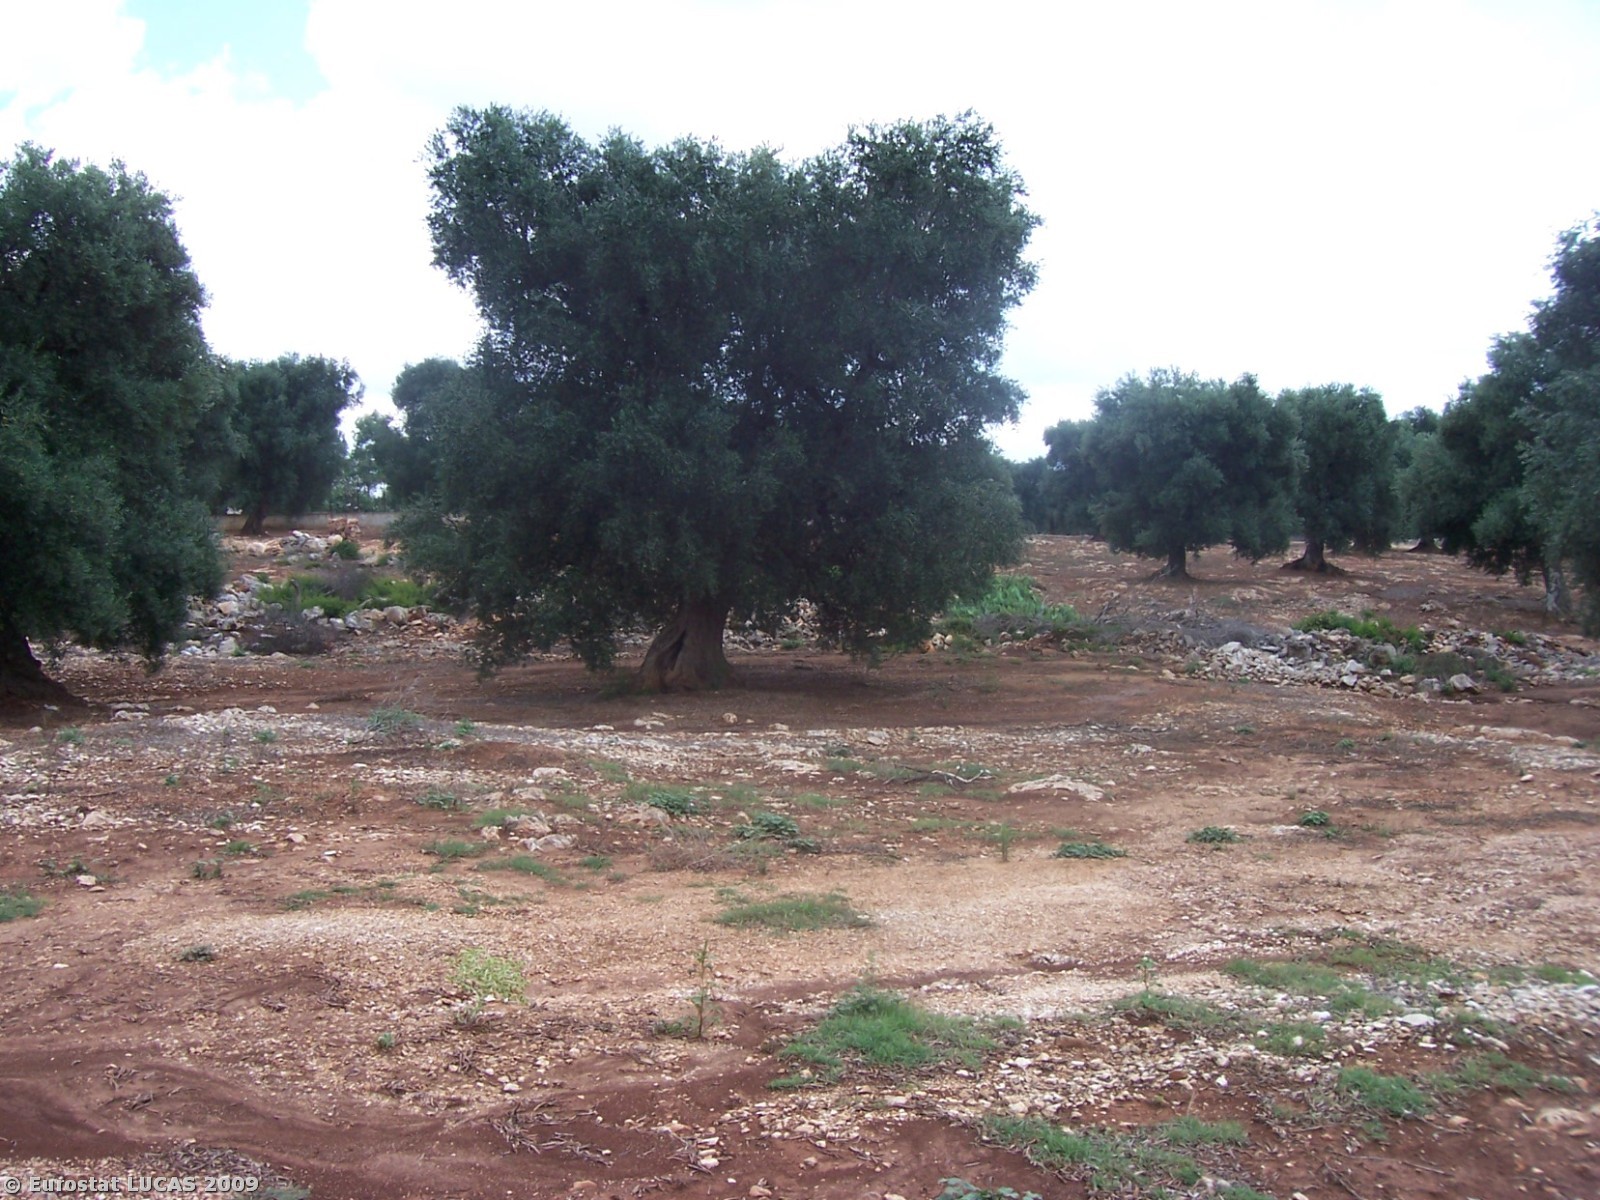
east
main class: Cropland
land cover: Olive groves
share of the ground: 50 - 75 %
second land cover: Bare land
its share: > 75 %
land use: Agriculture (excluding fallow land and kitchen gardens)
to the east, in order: Olive groves; Bare land; Tracks; Olive groves; Bare land; Rock outcrops; Olive groves; Bare land; Grass margins; Dry stone walls; Grass margins; Olive groves; Bare land; Dry stone walls; Olive groves; Bare land; Managed hedges; Fences; Grass margins; Paved roads, cycling and walking lanes; Grass margins; Olive groves; Bare land
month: July
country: IT
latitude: 40.5577
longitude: 17.5463
